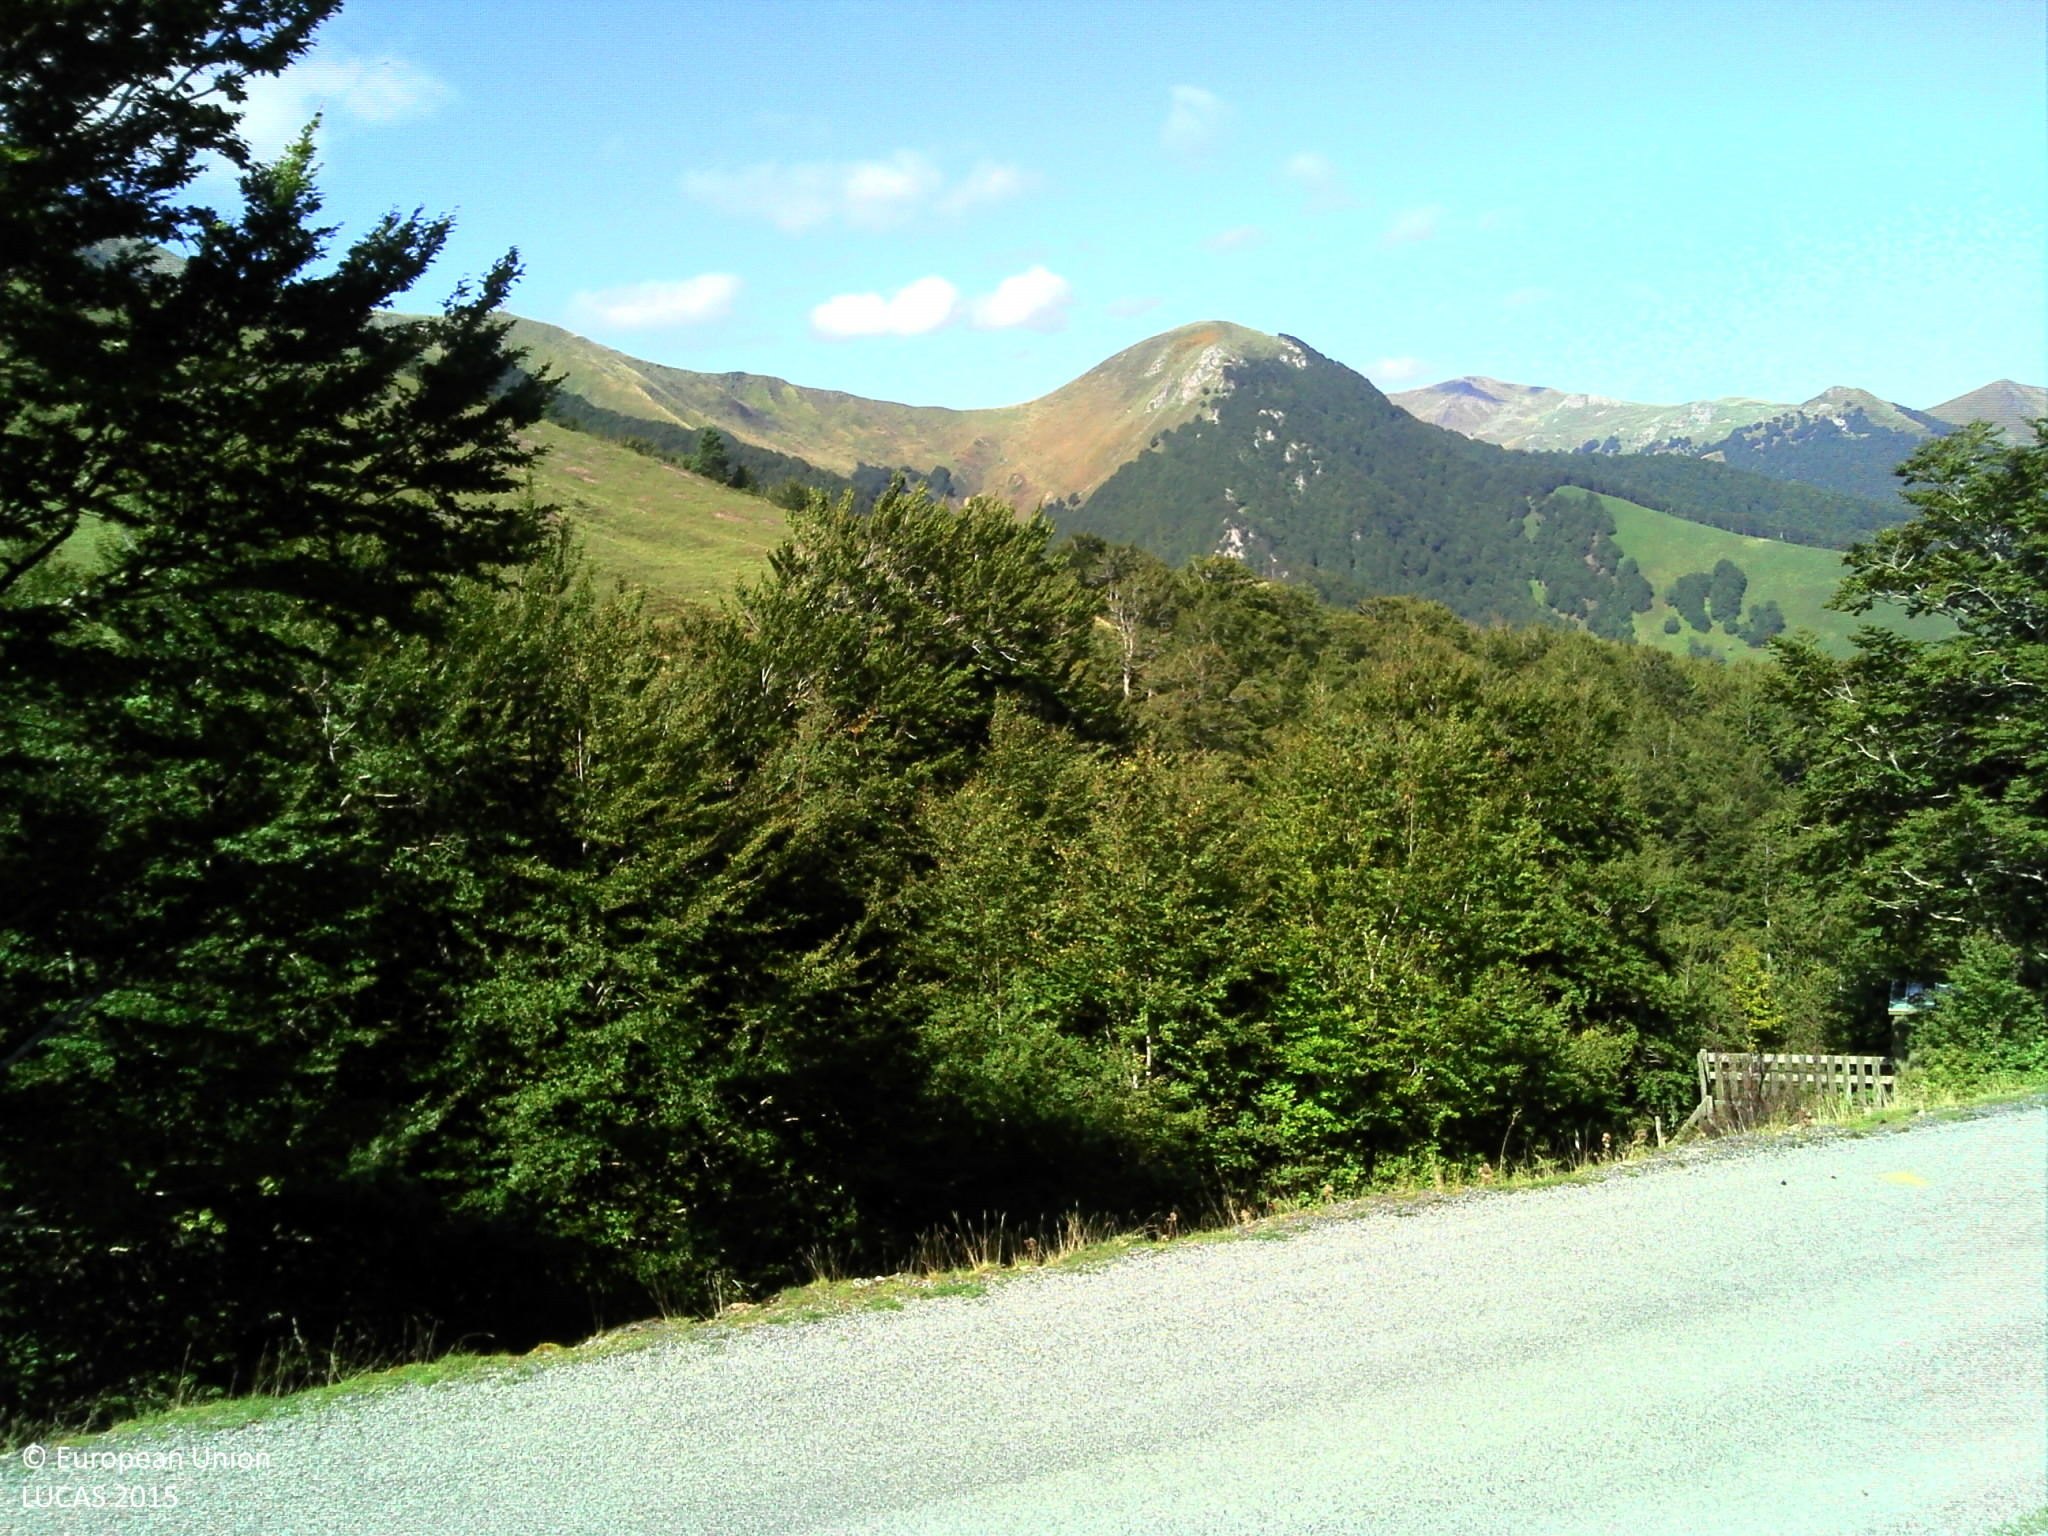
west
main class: Grassland
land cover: Spontaneously vegetated surfaces
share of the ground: 50 - 75 %
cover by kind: herbaceous plants 55 %, unconsolidated bare surface 30 %, consolidated bare surface 10 %, shrubs 5 %
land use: Agriculture (excluding fallow land and kitchen gardens)
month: September
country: FR
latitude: 43.0010
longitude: -0.9887
